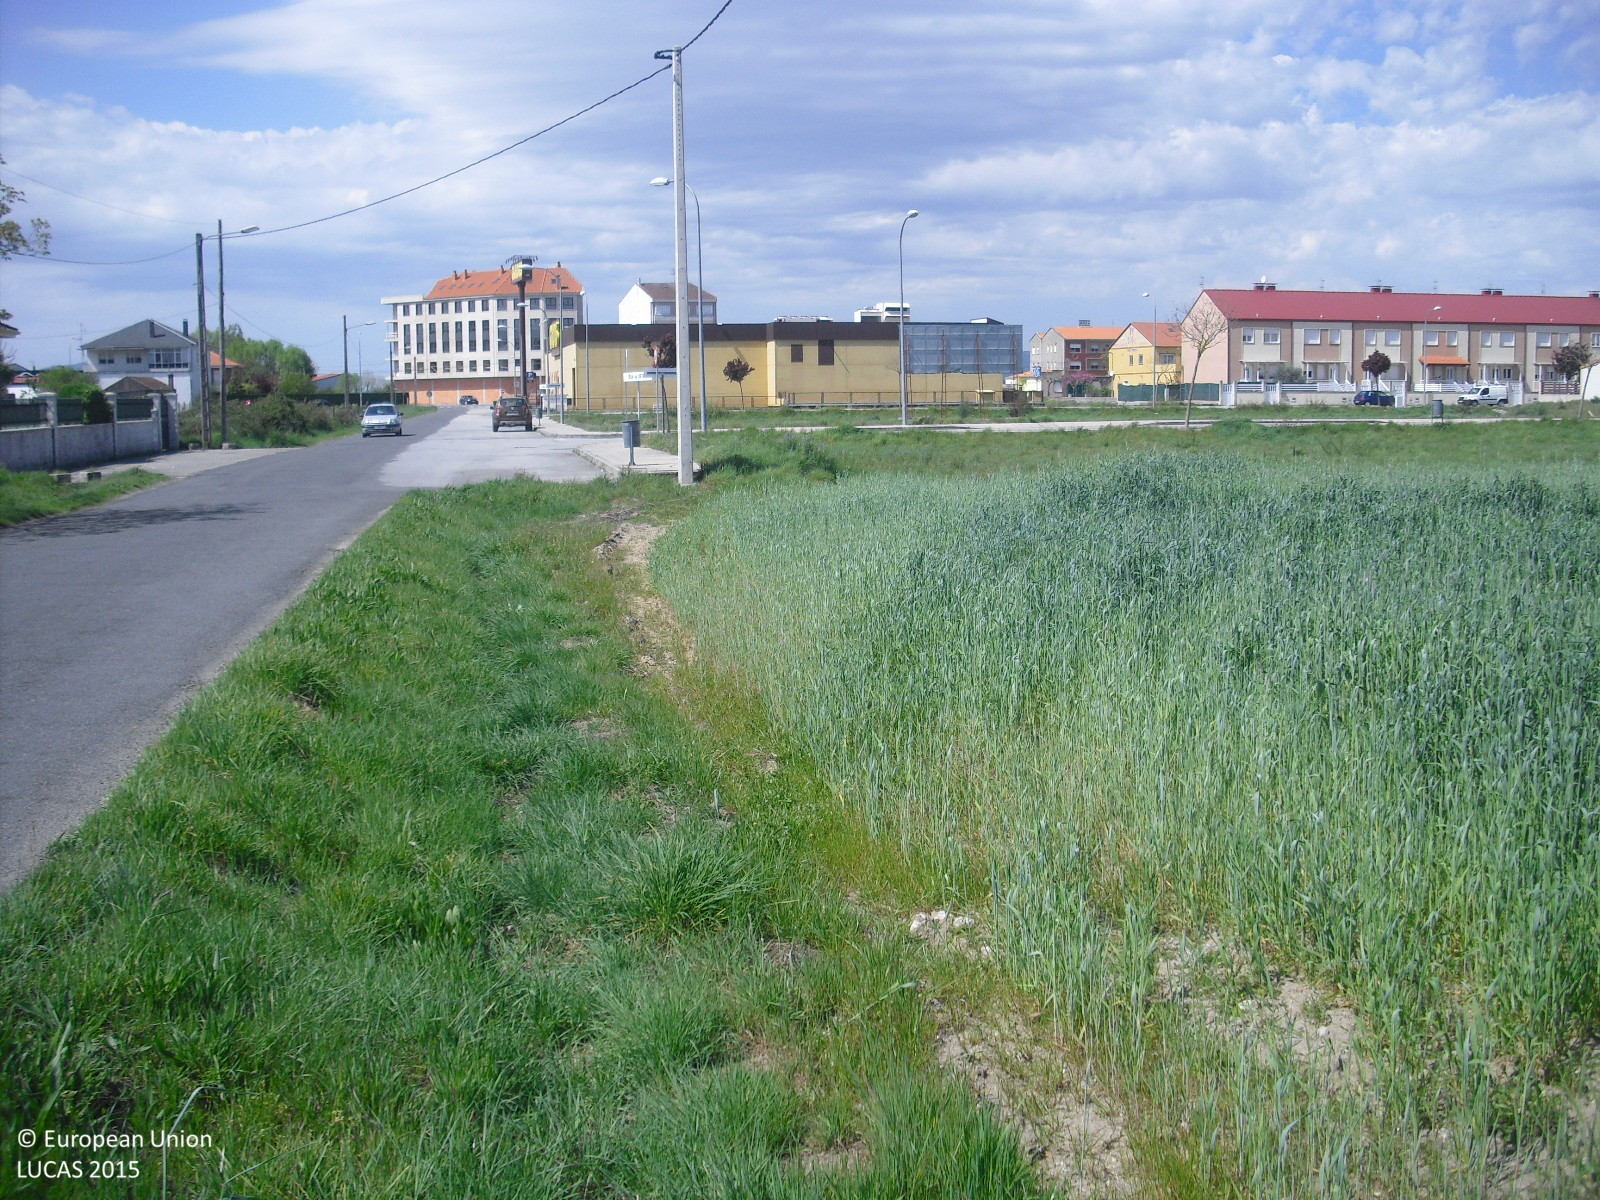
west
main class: Cropland
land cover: Rye
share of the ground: > 75 %
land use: Agriculture (excluding fallow land and kitchen gardens)
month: April
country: ES
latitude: 42.0715
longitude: -7.7277
